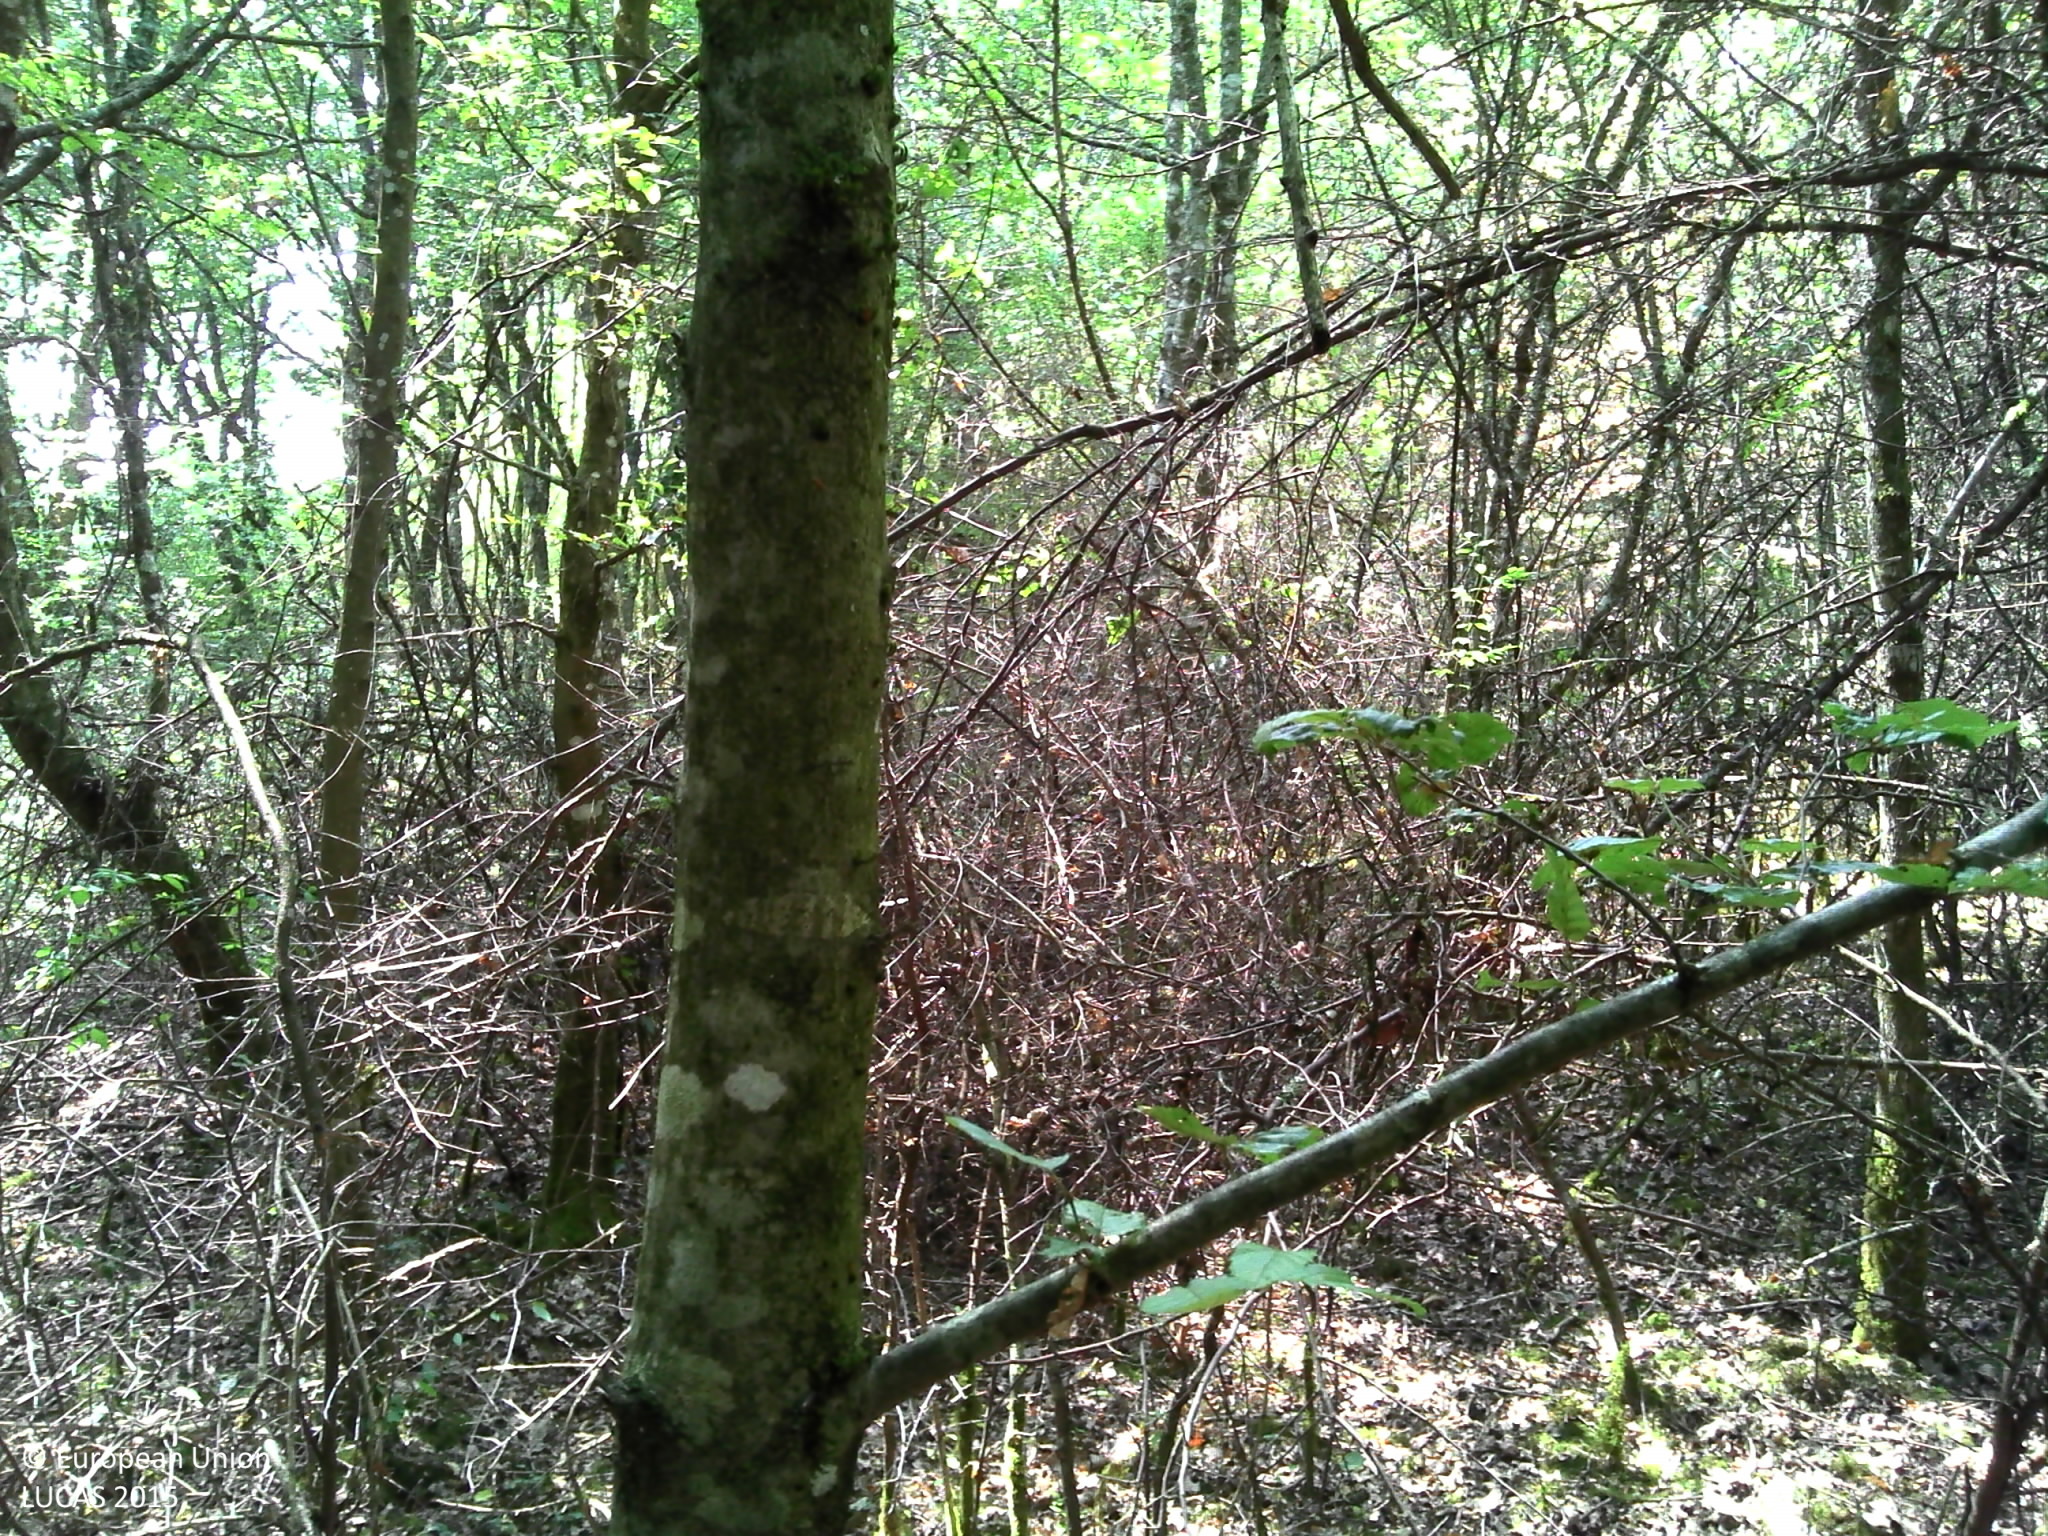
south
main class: Woodland
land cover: Broadleaved woodland
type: mesophytic deciduous forest
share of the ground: > 75 %
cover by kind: broadleaved forest trees 90 %, herbaceous plants 5 %, lichens and mosses 5 %
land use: Forestry
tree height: > 5 m
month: August
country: FR
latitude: 47.7397
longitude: 3.1530
